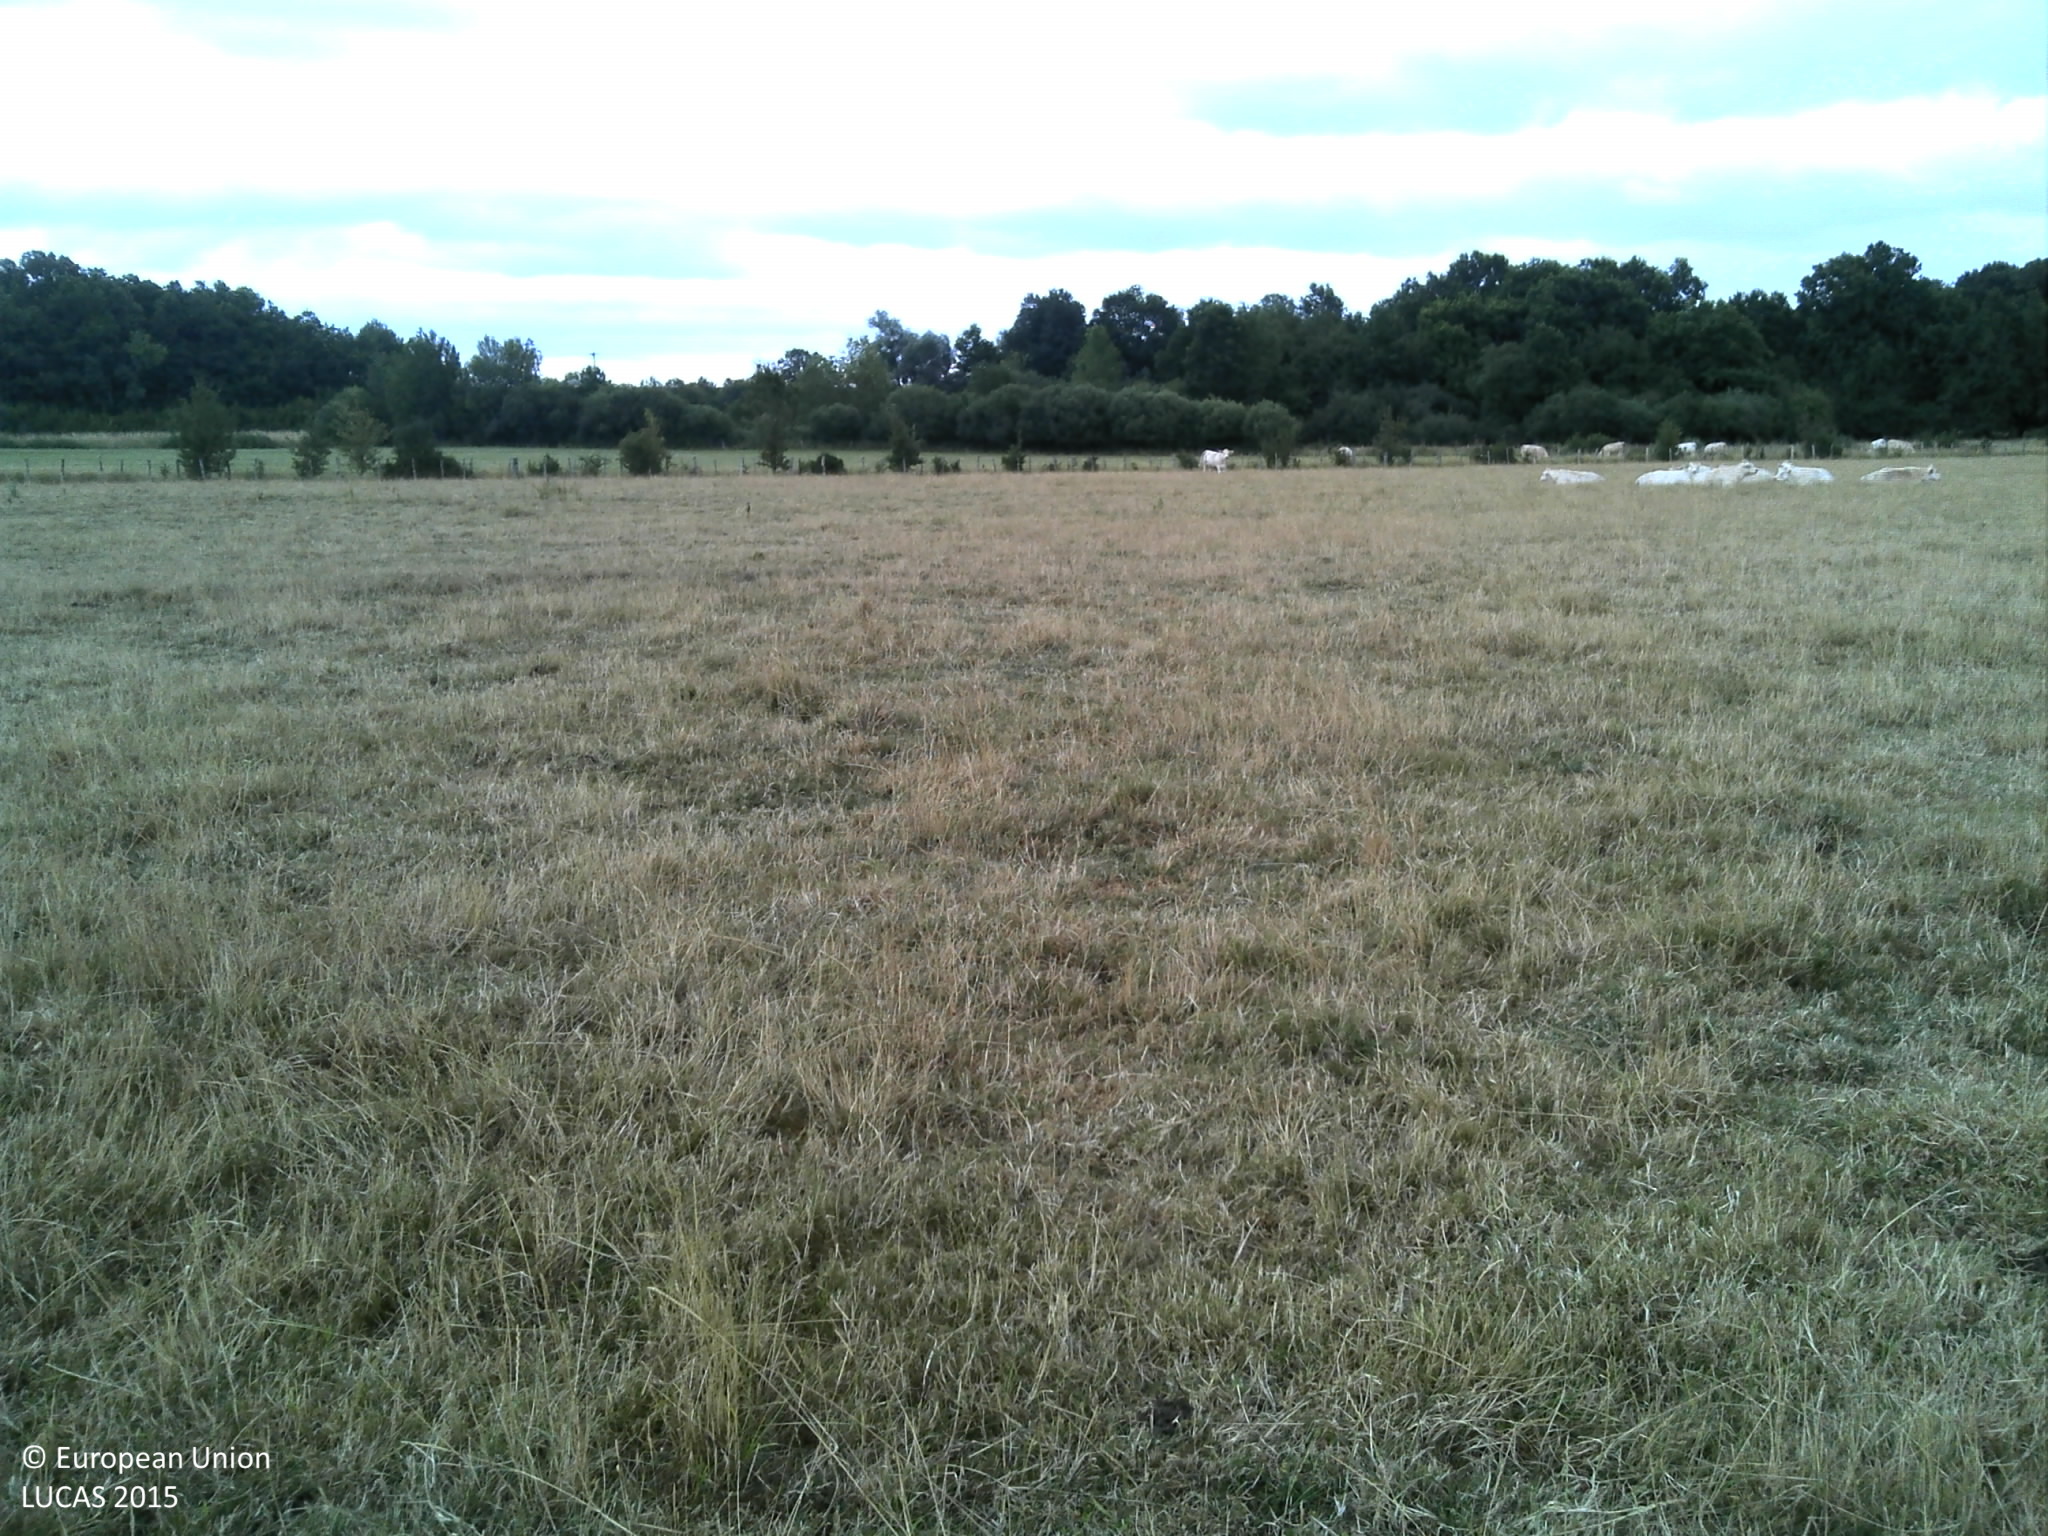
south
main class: Grassland
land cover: Grassland without tree/shrub cover
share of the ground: > 75 %
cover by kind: herbaceous plants 100 %
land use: Agriculture (excluding fallow land and kitchen gardens)
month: July
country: FR
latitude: 48.5649
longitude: 4.6992
